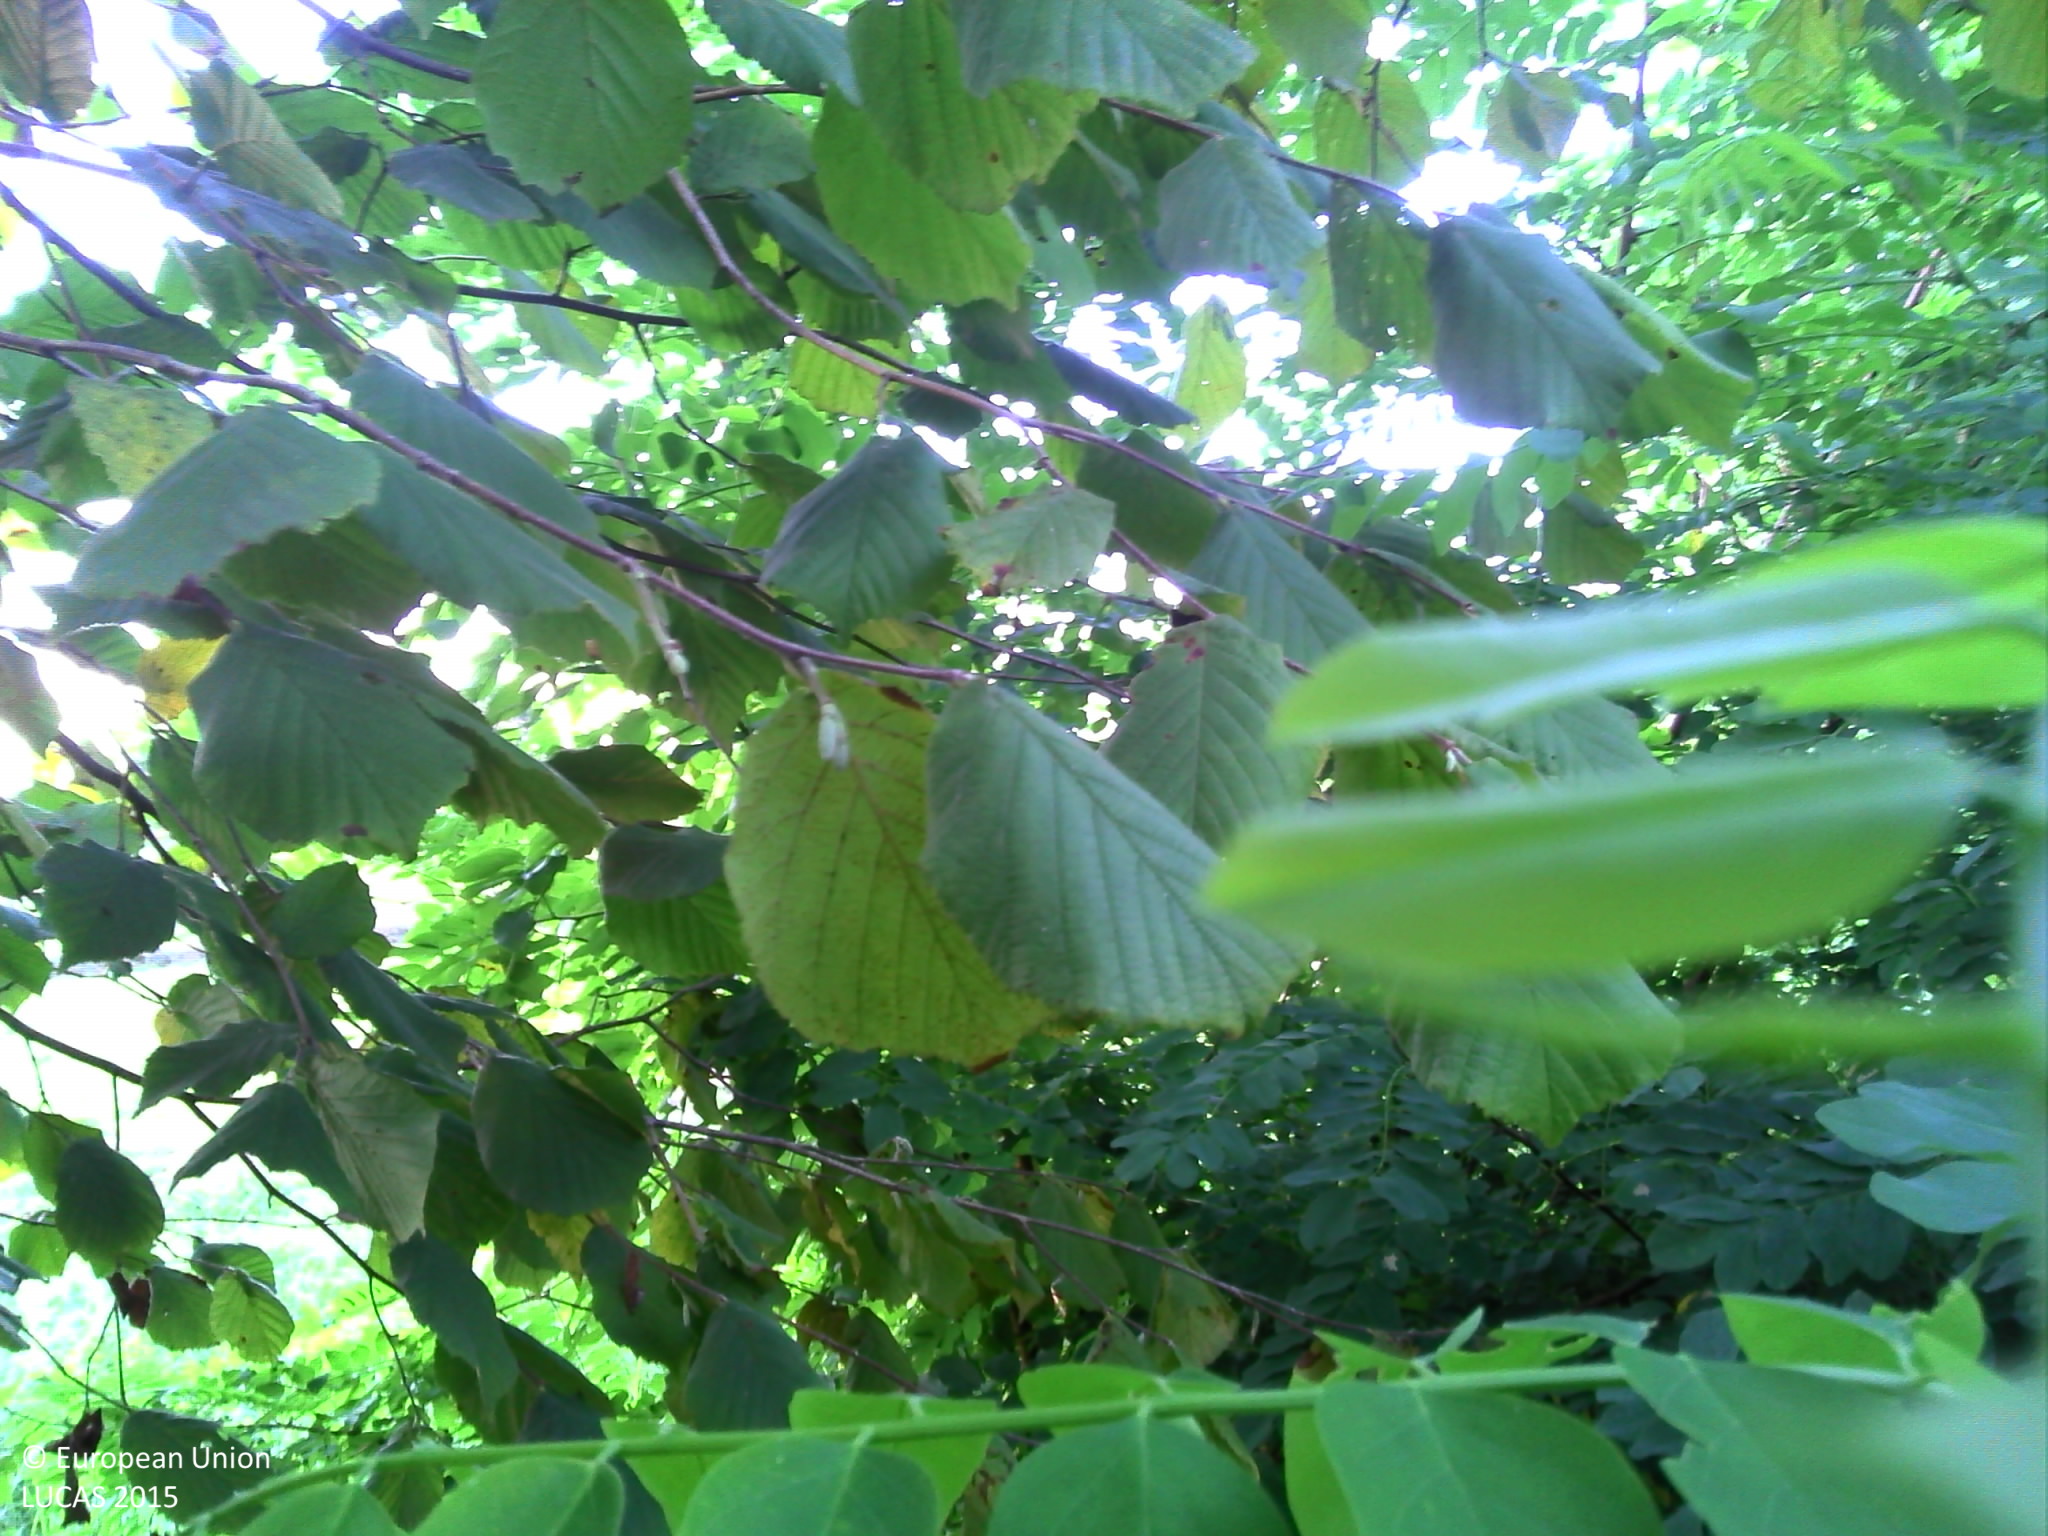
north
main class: Woodland
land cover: Broadleaved woodland
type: floodplain forest
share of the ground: 50 - 75 %
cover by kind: broadleaved forest trees 70 %, shrubs 30 %
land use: Semi-natural and natural areas not in use
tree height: > 5 m
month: September
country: FR
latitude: 43.3708
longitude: -0.9340
